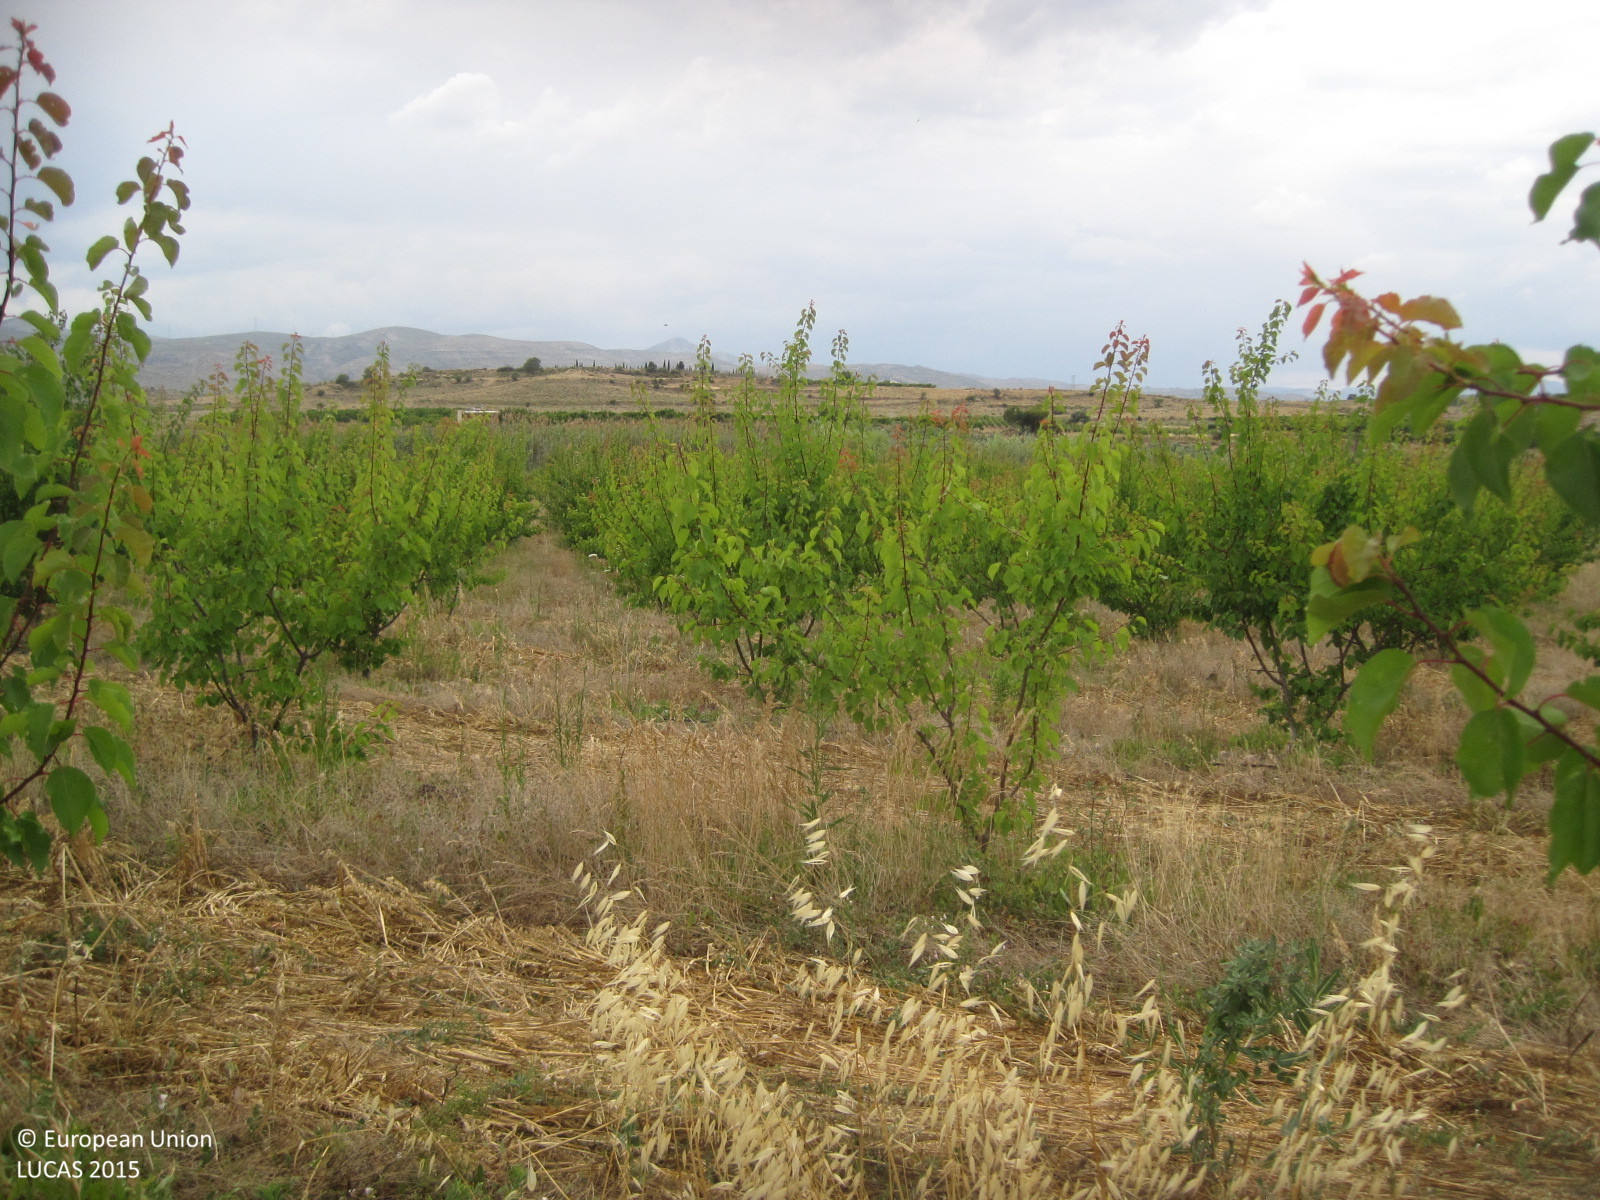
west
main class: Cropland
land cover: Other fruit trees and berries
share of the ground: 10 - 25 %
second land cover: Spontaneously vegetated surfaces
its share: > 75 %
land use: Agriculture (excluding fallow land and kitchen gardens)
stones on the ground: 10 - 25 %
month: June
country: ES
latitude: 39.3075
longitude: -0.6079
